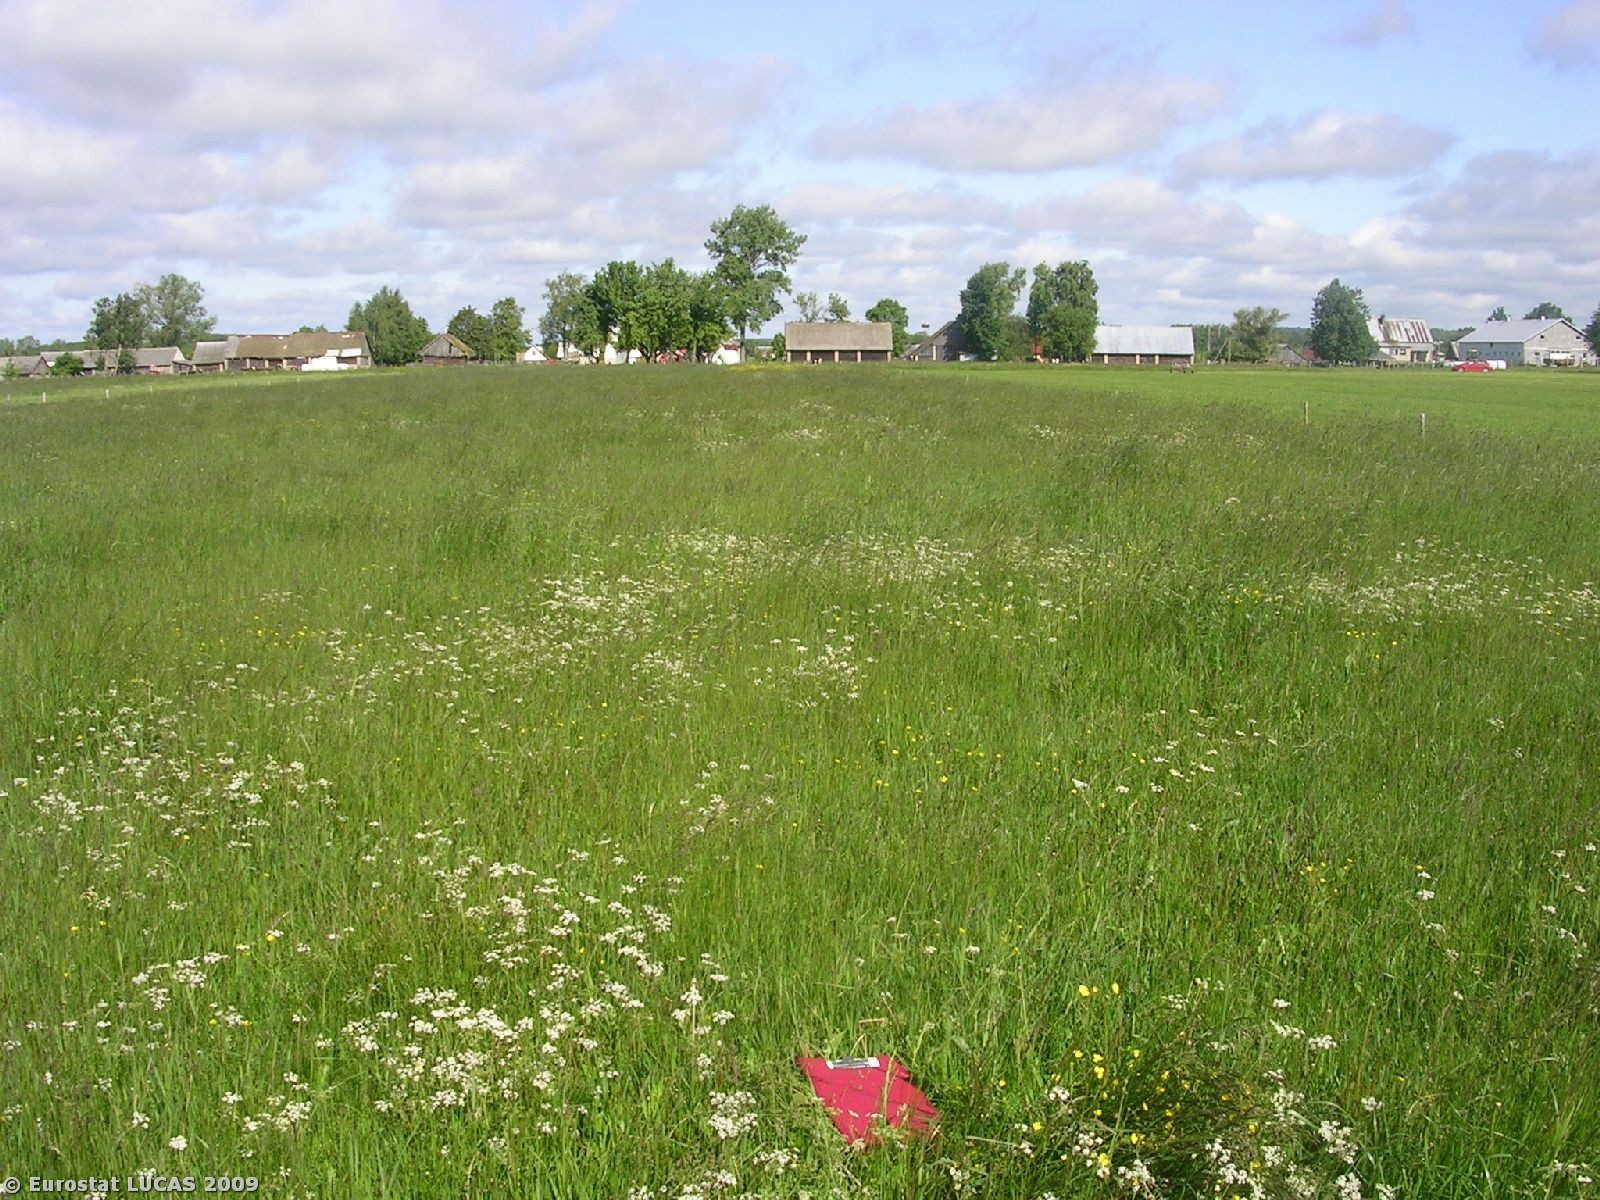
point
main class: Grassland
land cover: Grassland without tree/shrub cover
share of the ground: > 75 %
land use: Agriculture (excluding fallow land and kitchen gardens)
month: August
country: PL
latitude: 53.4207
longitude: 23.7057
